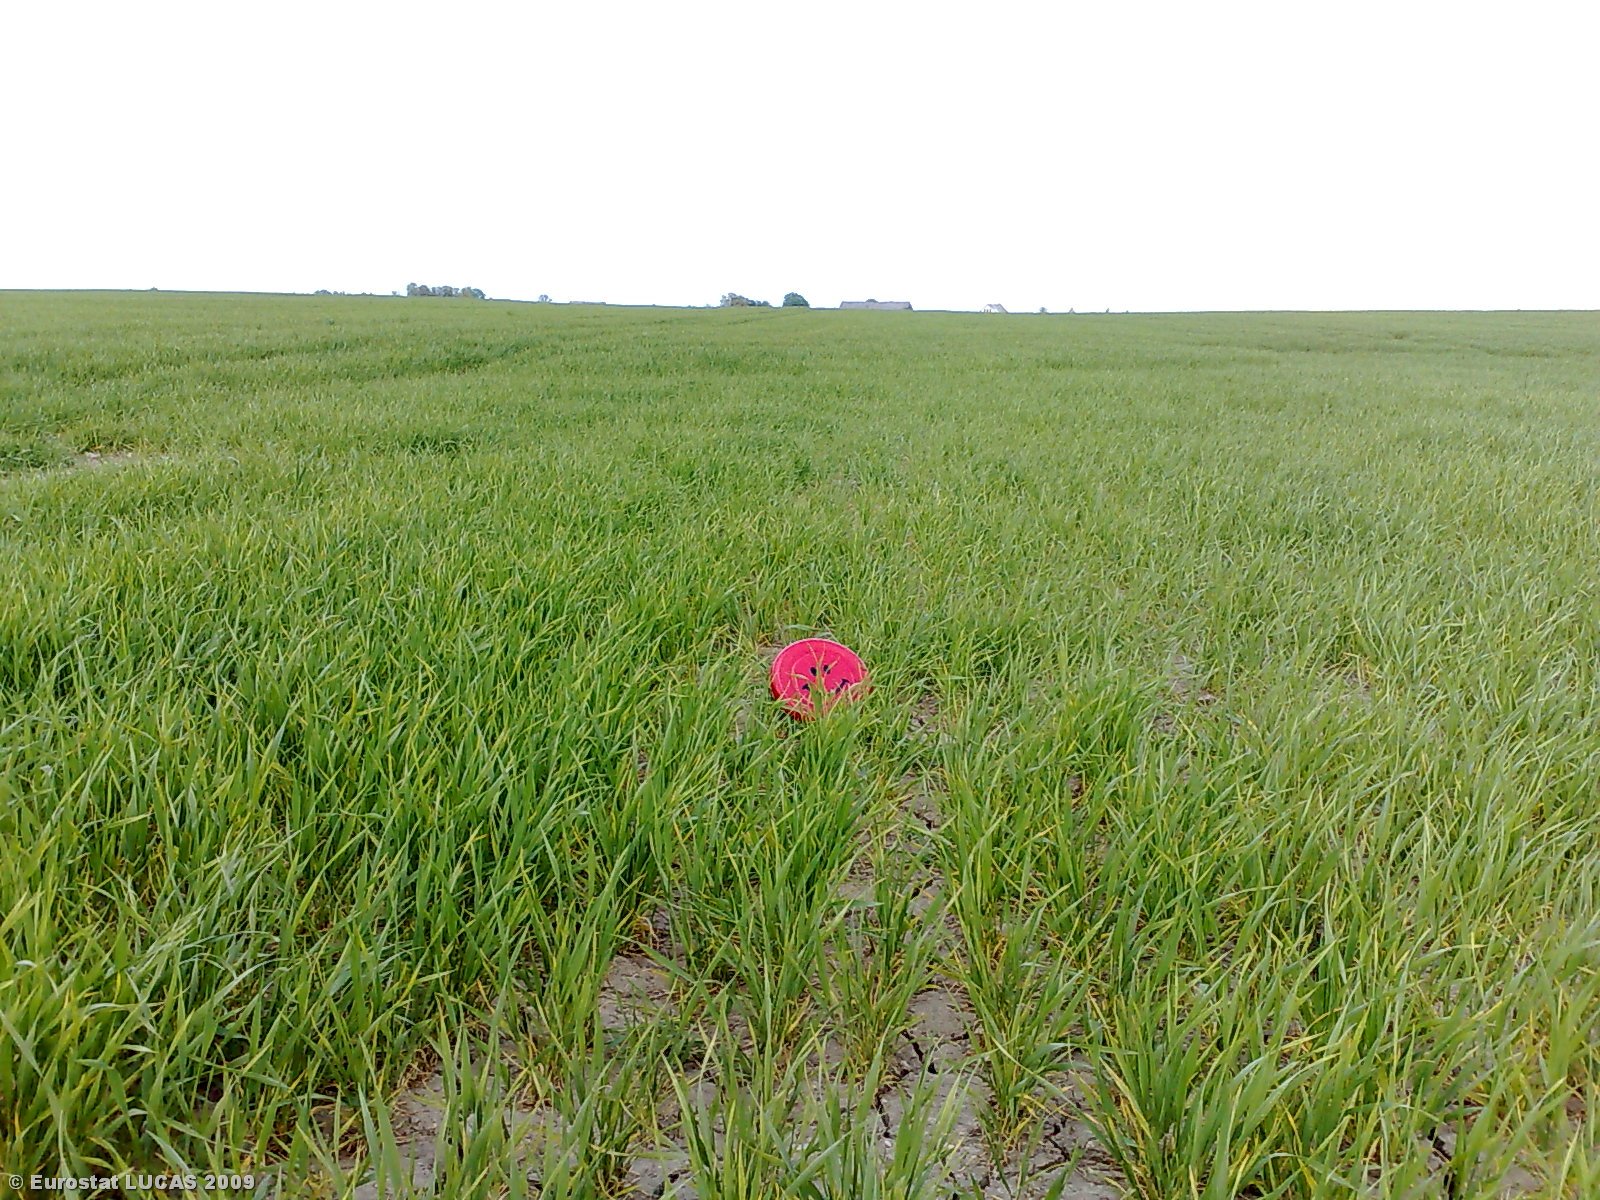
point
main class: Cropland
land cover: Common wheat
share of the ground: 50 - 75 %
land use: Agriculture (excluding fallow land and kitchen gardens)
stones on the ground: < 10 %
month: May
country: LT
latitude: 55.5616
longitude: 23.8321
